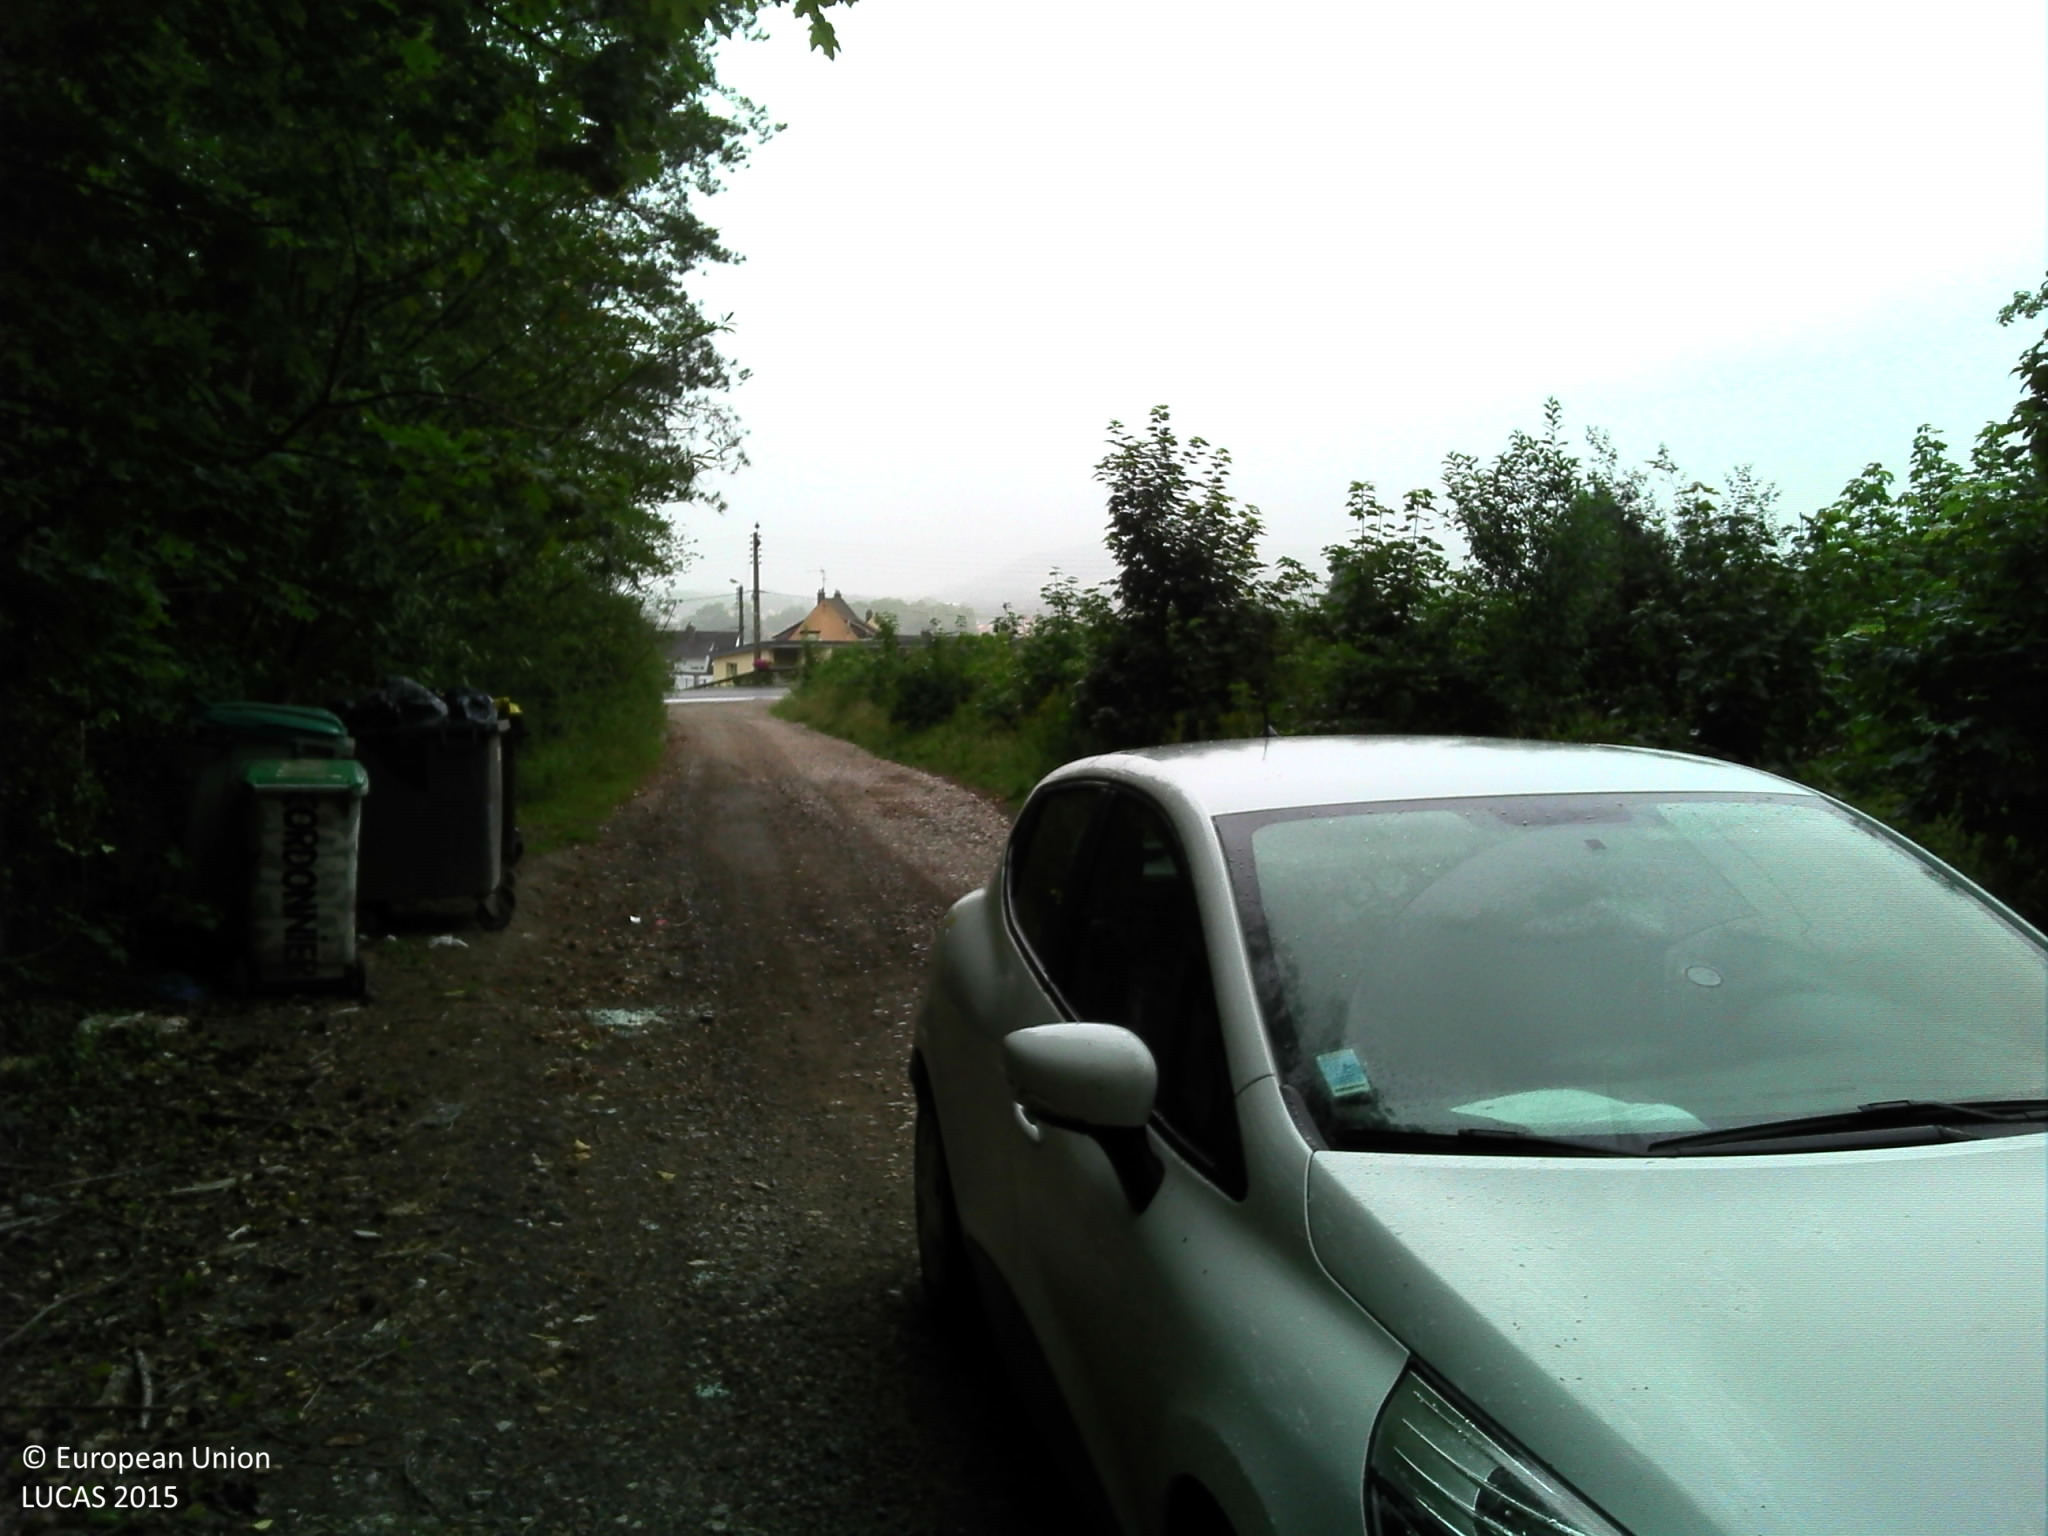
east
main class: Woodland
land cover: Broadleaved woodland
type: mesophytic deciduous forest
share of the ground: > 75 %
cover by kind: broadleaved forest trees 70 %, herbaceous plants 30 %
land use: Residential
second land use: Forestry
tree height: > 5 m
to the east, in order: Broadleaved woodland; Artificial constructions in urban areas; Broadleaved woodland; Tracks; Broadleaved woodland
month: July
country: FR
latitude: 50.6152
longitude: 1.6007
